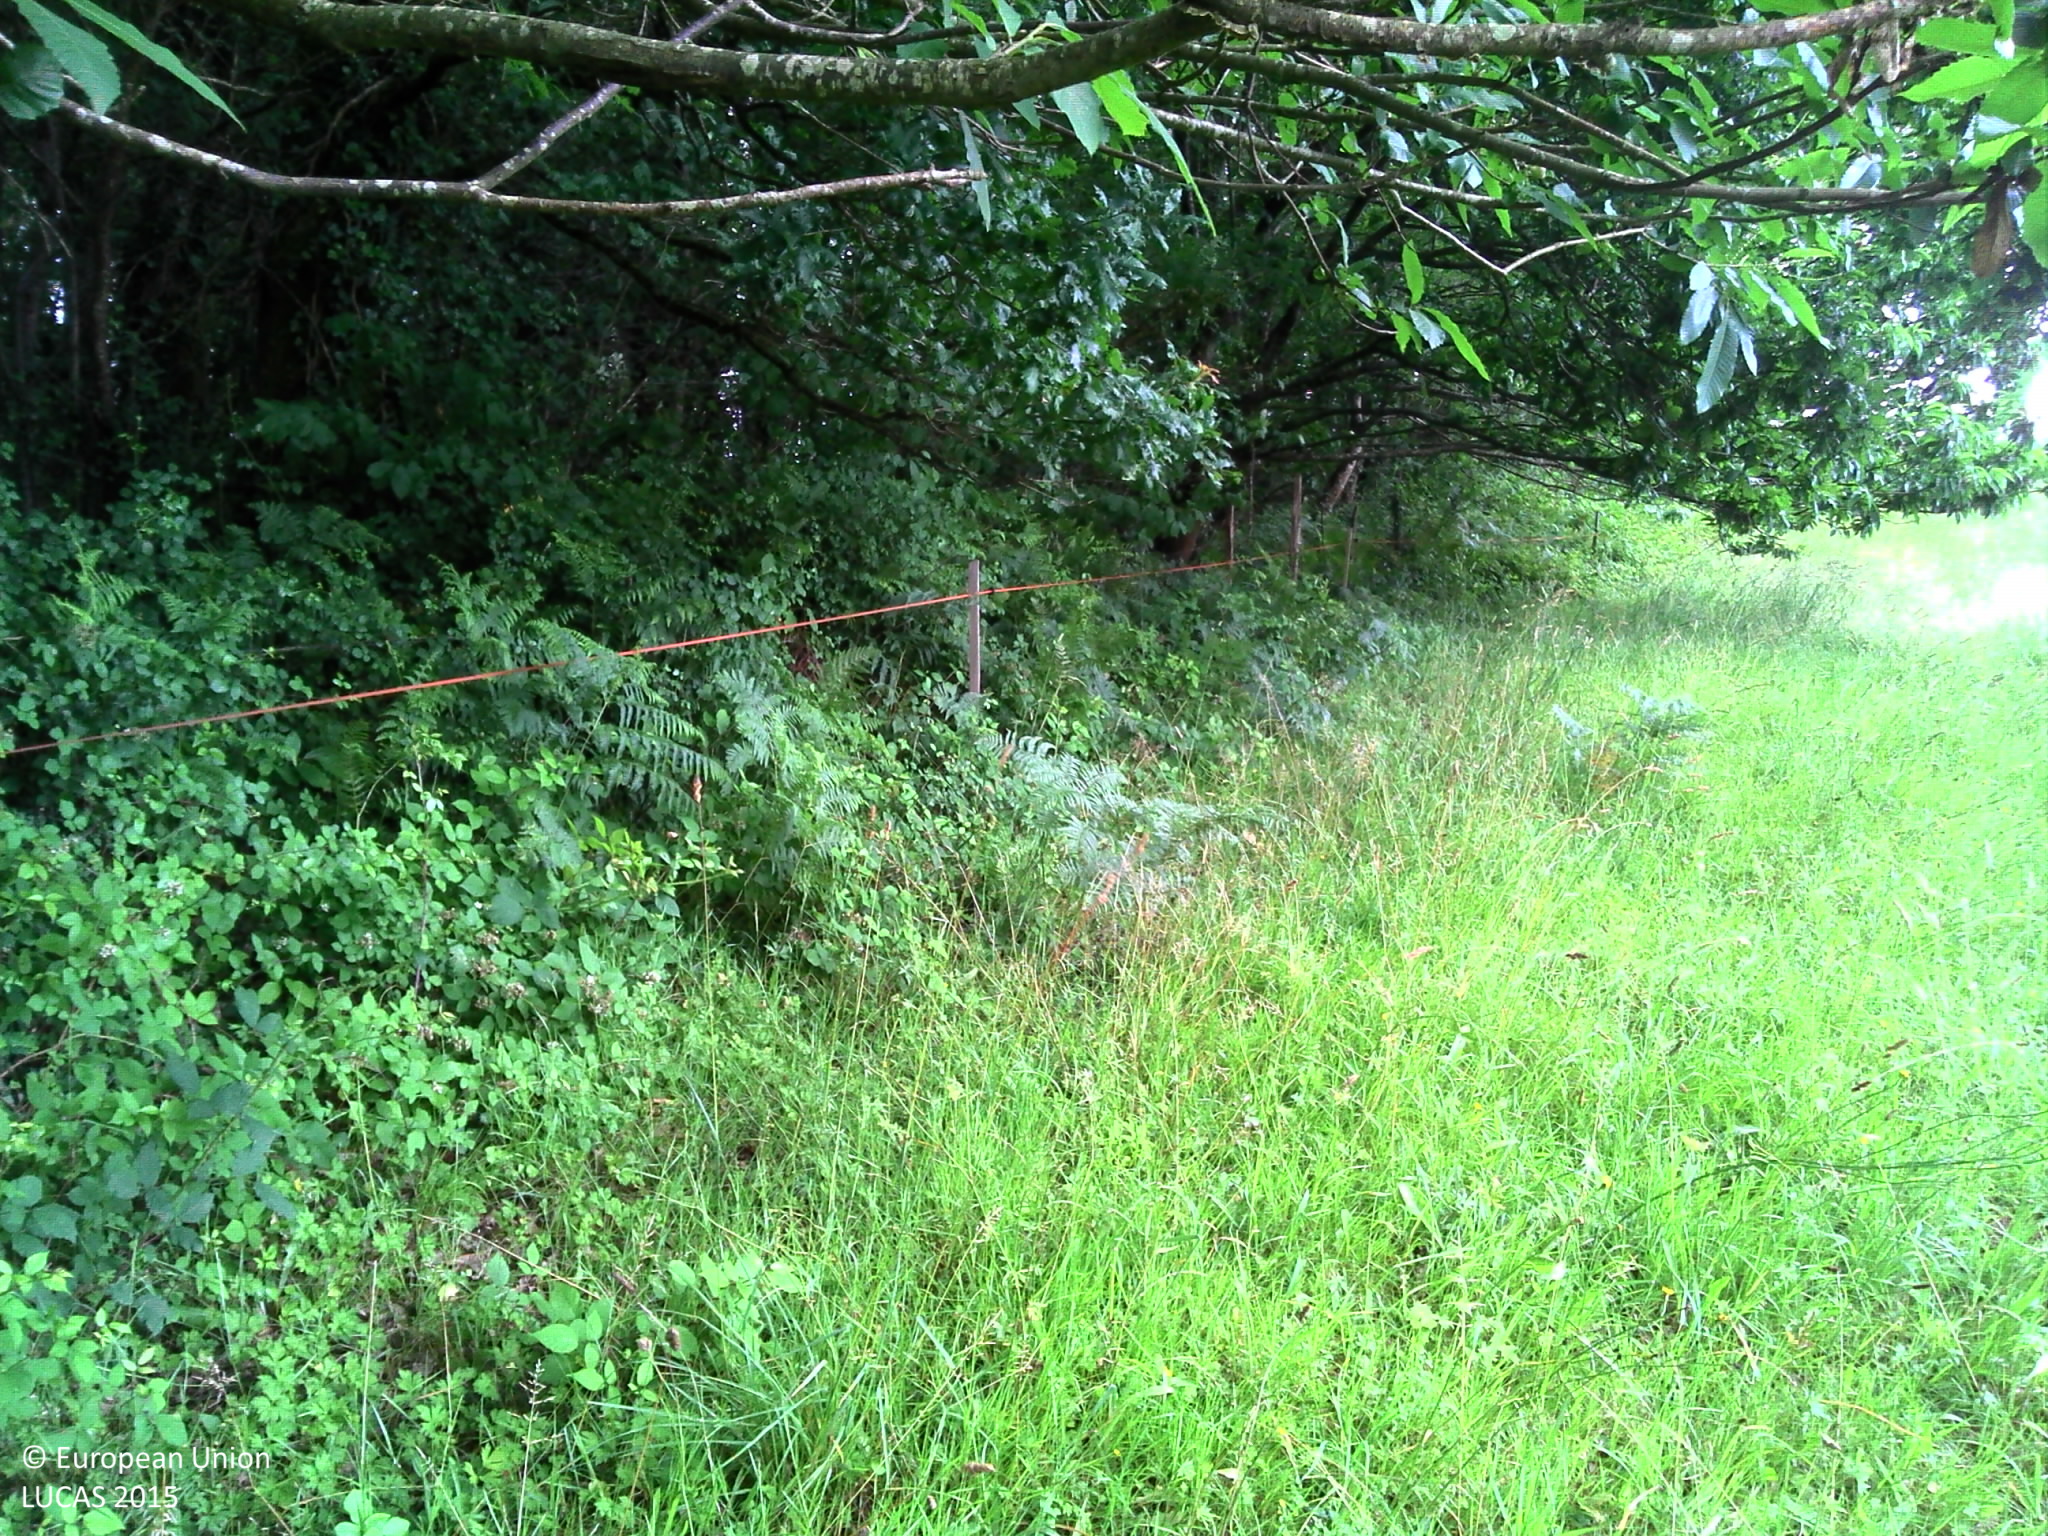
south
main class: Grassland
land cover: Grassland without tree/shrub cover
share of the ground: > 75 %
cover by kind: herbaceous plants 100 %
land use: Agriculture (excluding fallow land and kitchen gardens)
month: June
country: FR
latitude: 43.3024
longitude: -0.7222
